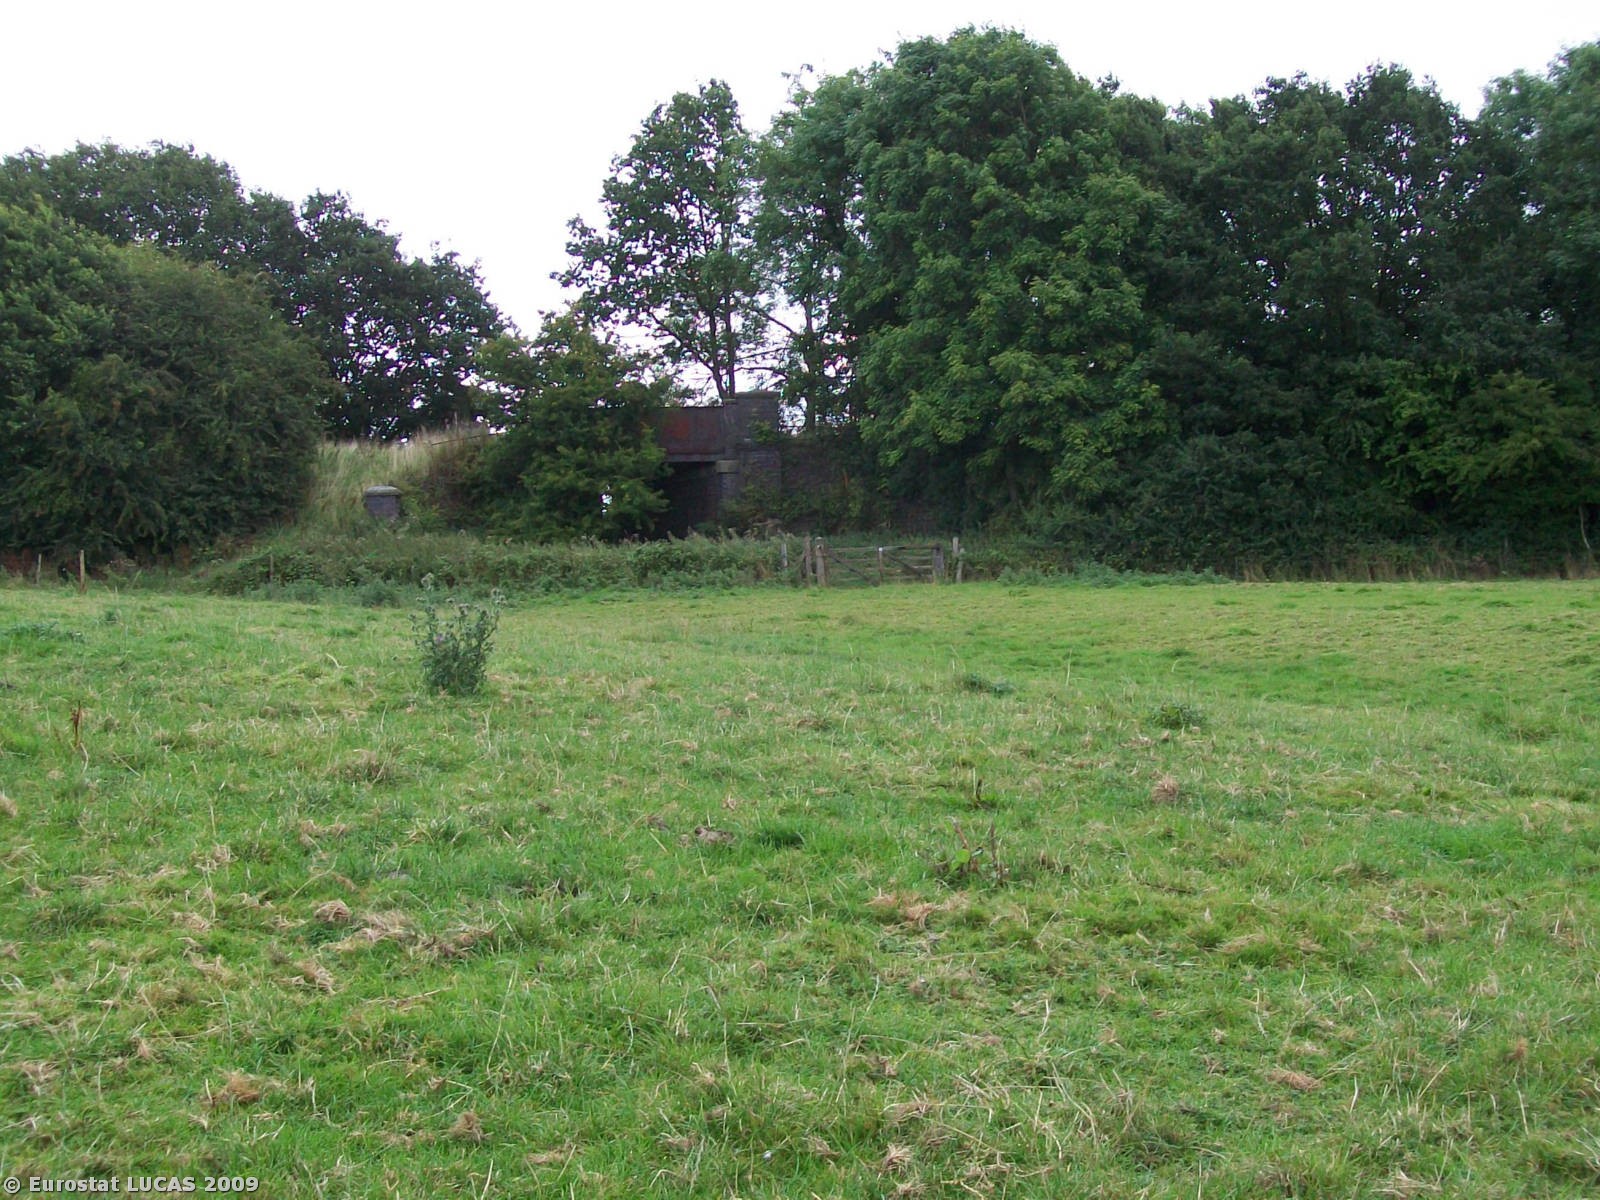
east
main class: Grassland
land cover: Grassland without tree/shrub cover
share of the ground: > 75 %
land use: Agriculture (excluding fallow land and kitchen gardens)
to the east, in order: Grassland without tree/shrub cover; Fences; Abandoned hedges; Railways; Abandoned hedges; Managed hedges; Grassland without tree/shrub cover; Barley; Common wheat
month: August
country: GB
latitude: 52.1161
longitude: -1.2191
